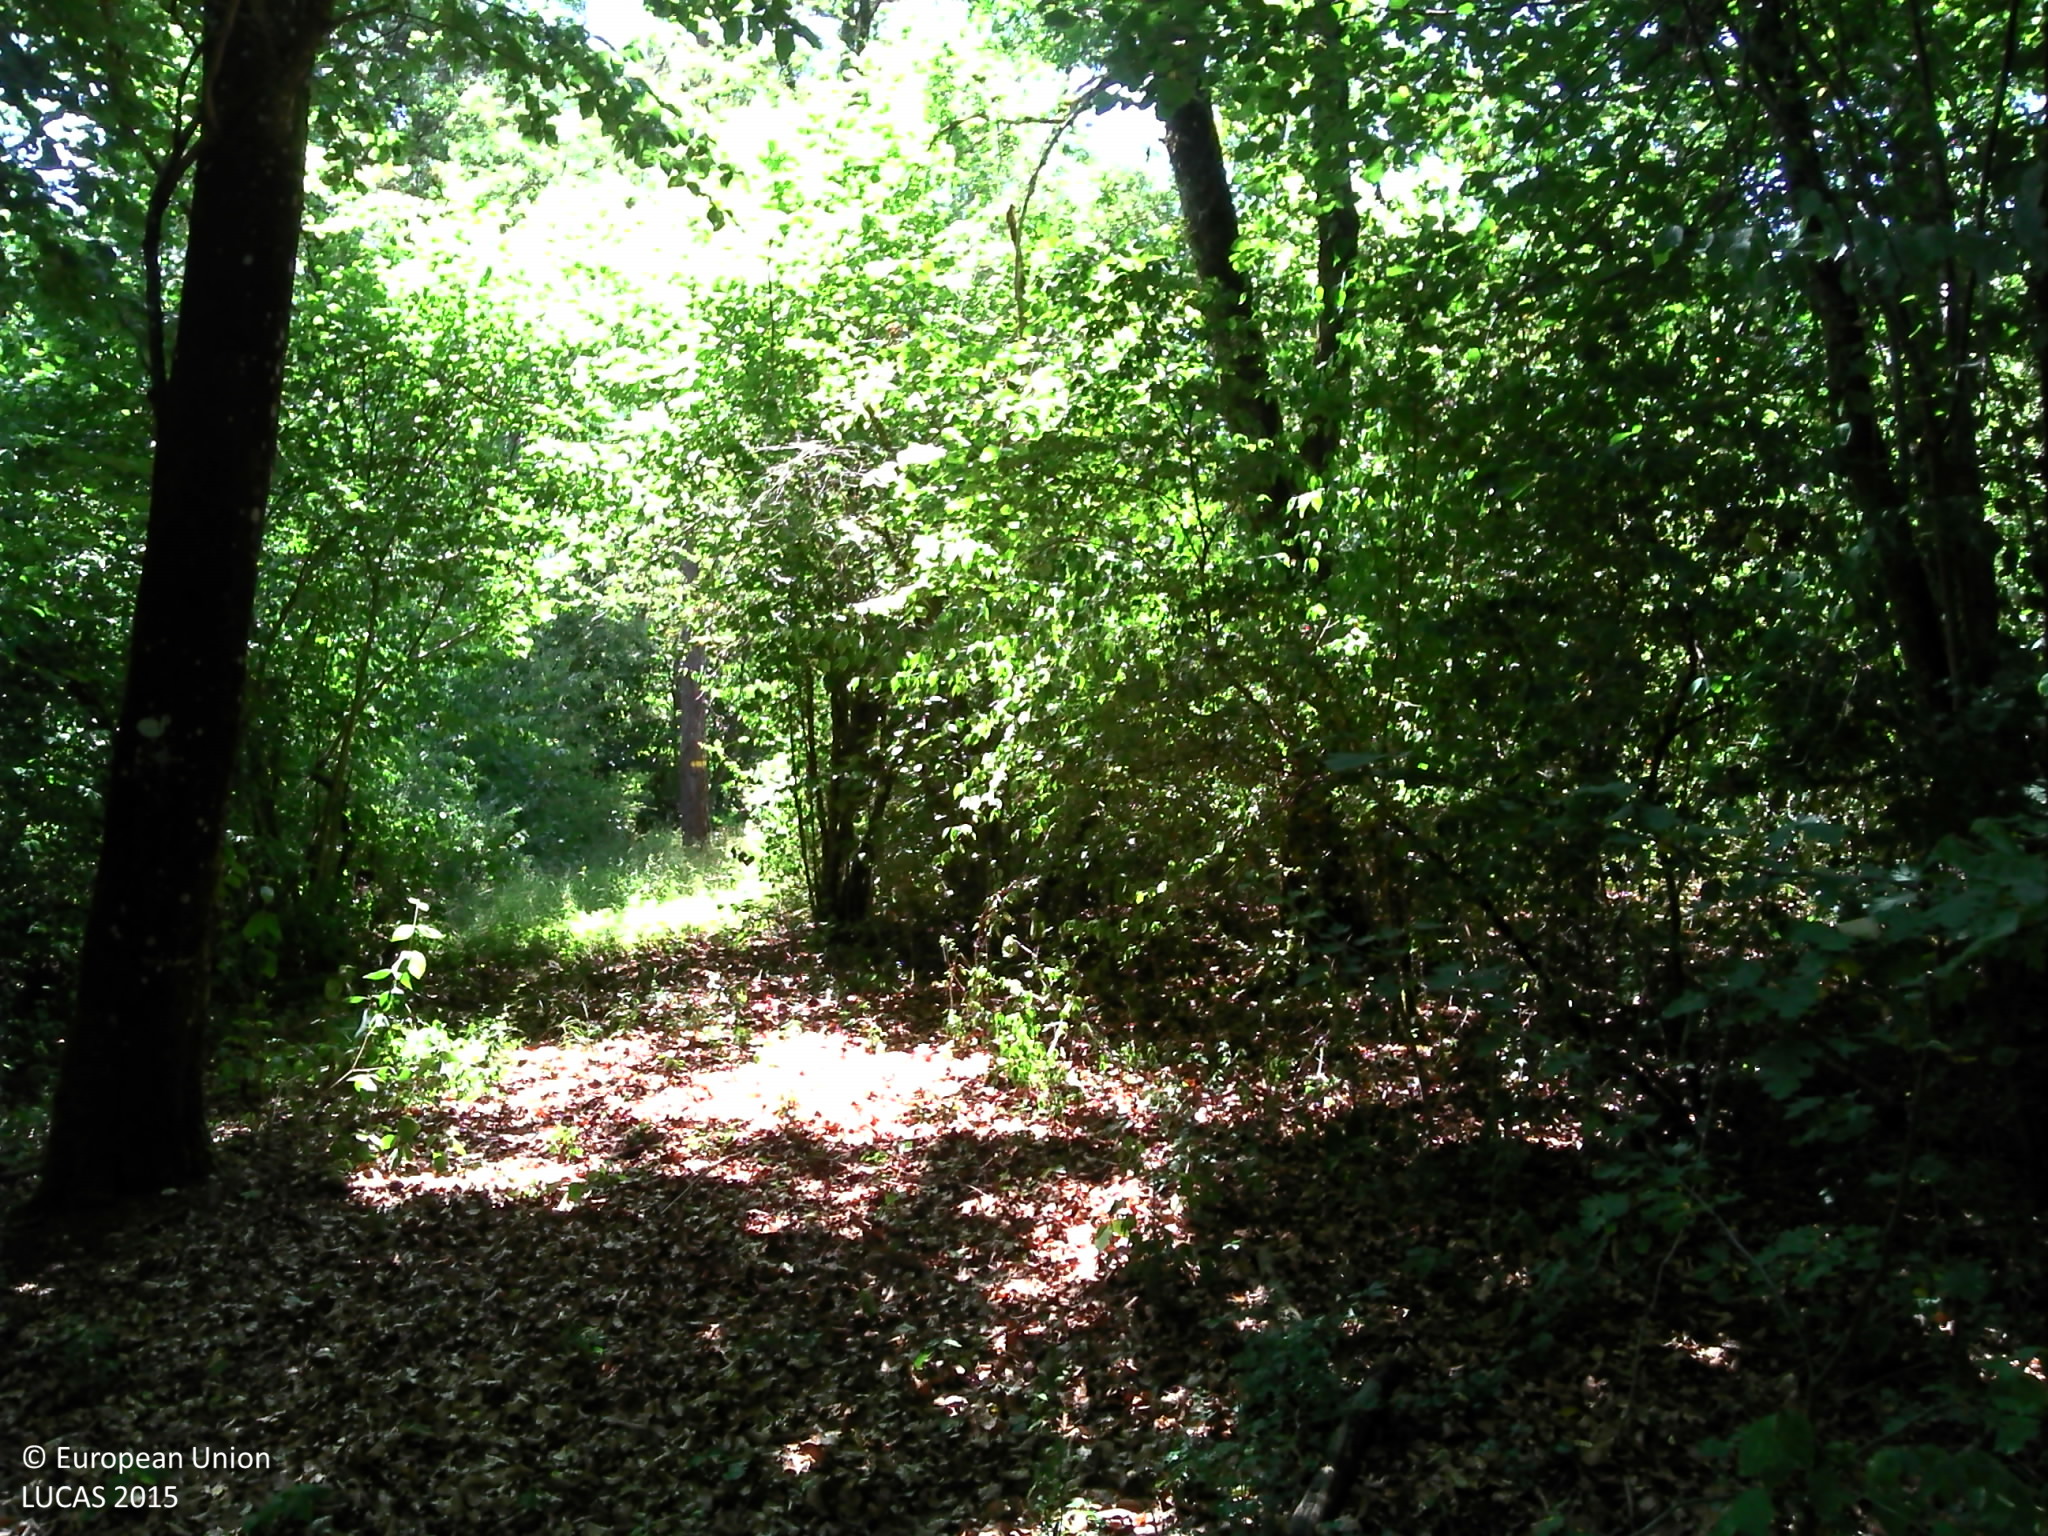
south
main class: Woodland
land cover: Broadleaved woodland
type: acidophilous oak and oak-birch forest
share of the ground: > 75 %
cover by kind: broadleaved forest trees 80 %, herbaceous plants 10 %, lichens and mosses 10 %
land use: Forestry
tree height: > 5 m
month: July
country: FR
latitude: 47.8835
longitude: 5.1722
